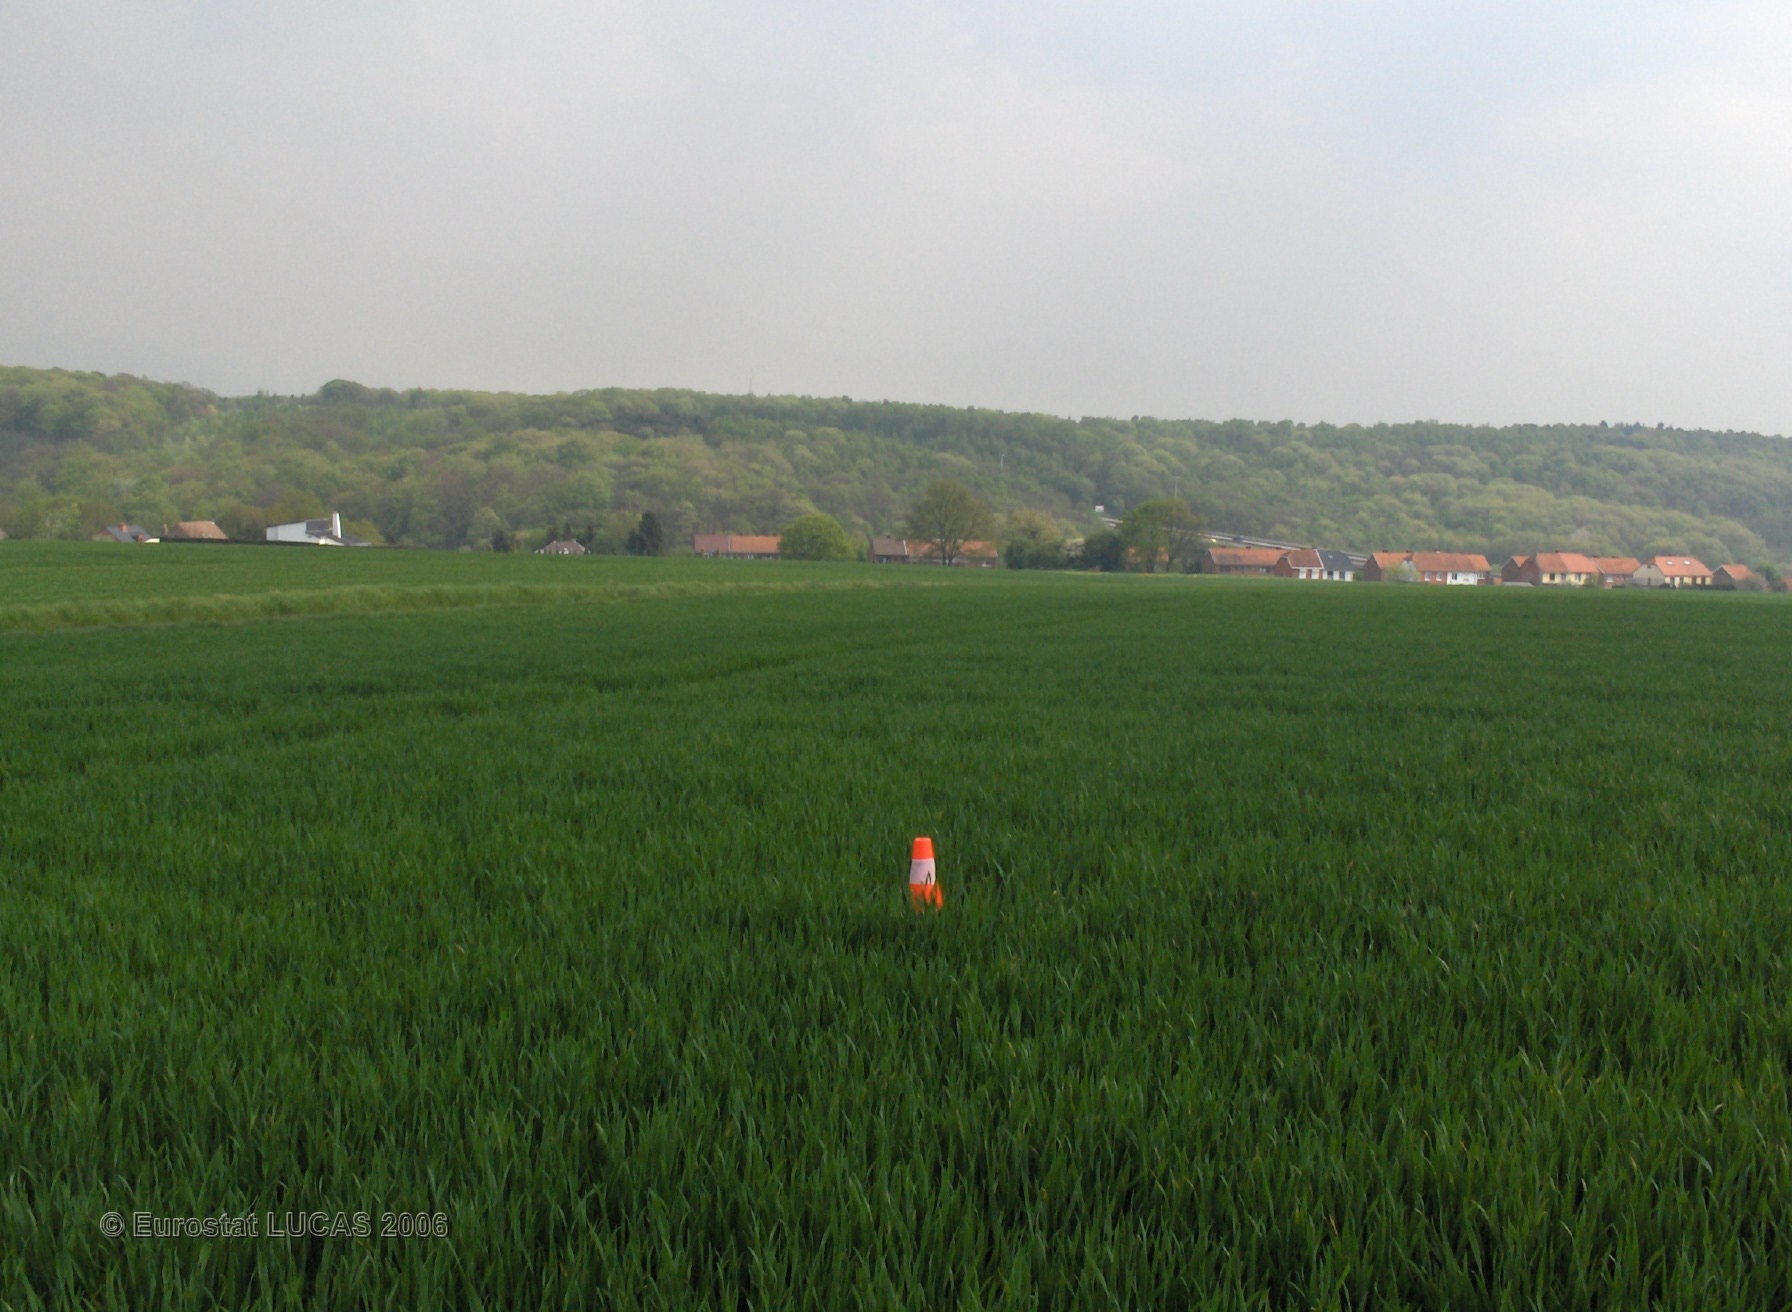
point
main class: Cropland
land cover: Common wheat
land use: Agriculture (excluding fallow land and kitchen gardens)
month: May
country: BE
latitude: 50.6295
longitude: 4.5248
